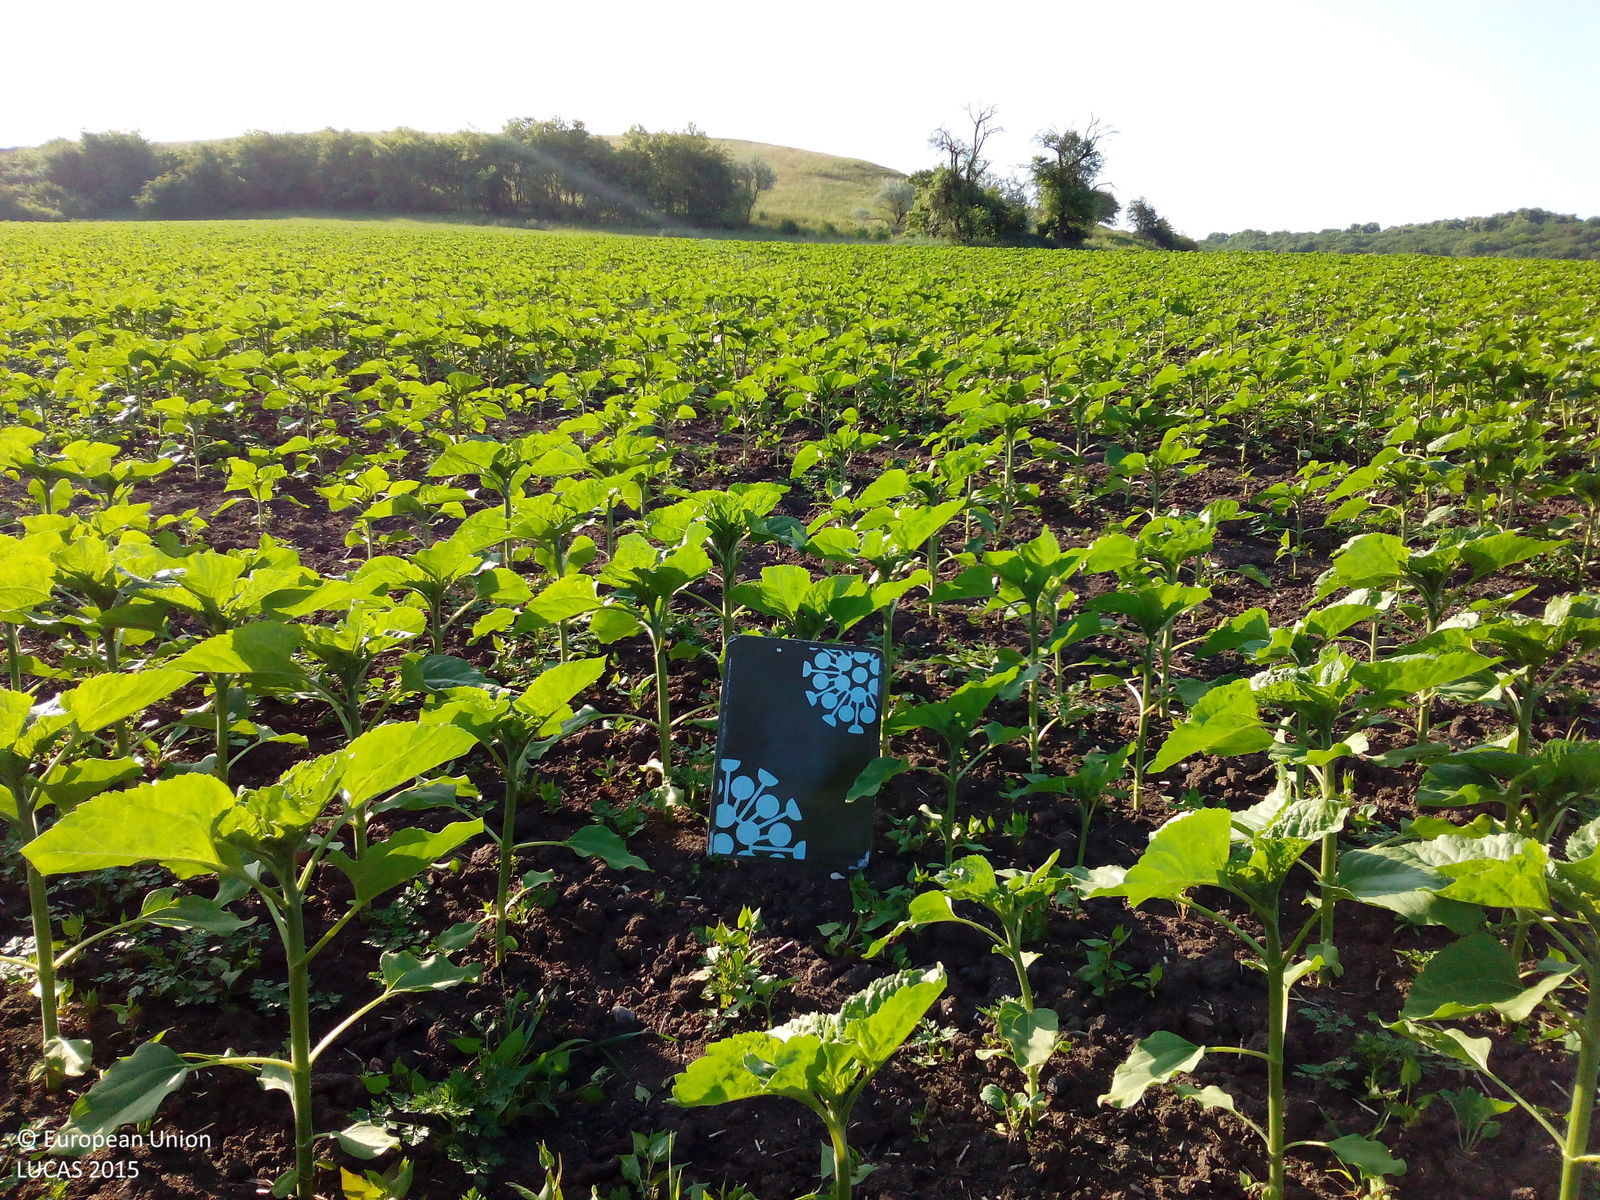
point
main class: Cropland
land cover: Sunflower
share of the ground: > 75 %
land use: Agriculture (excluding fallow land and kitchen gardens)
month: June
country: DE
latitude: 51.1641
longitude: 11.4440
